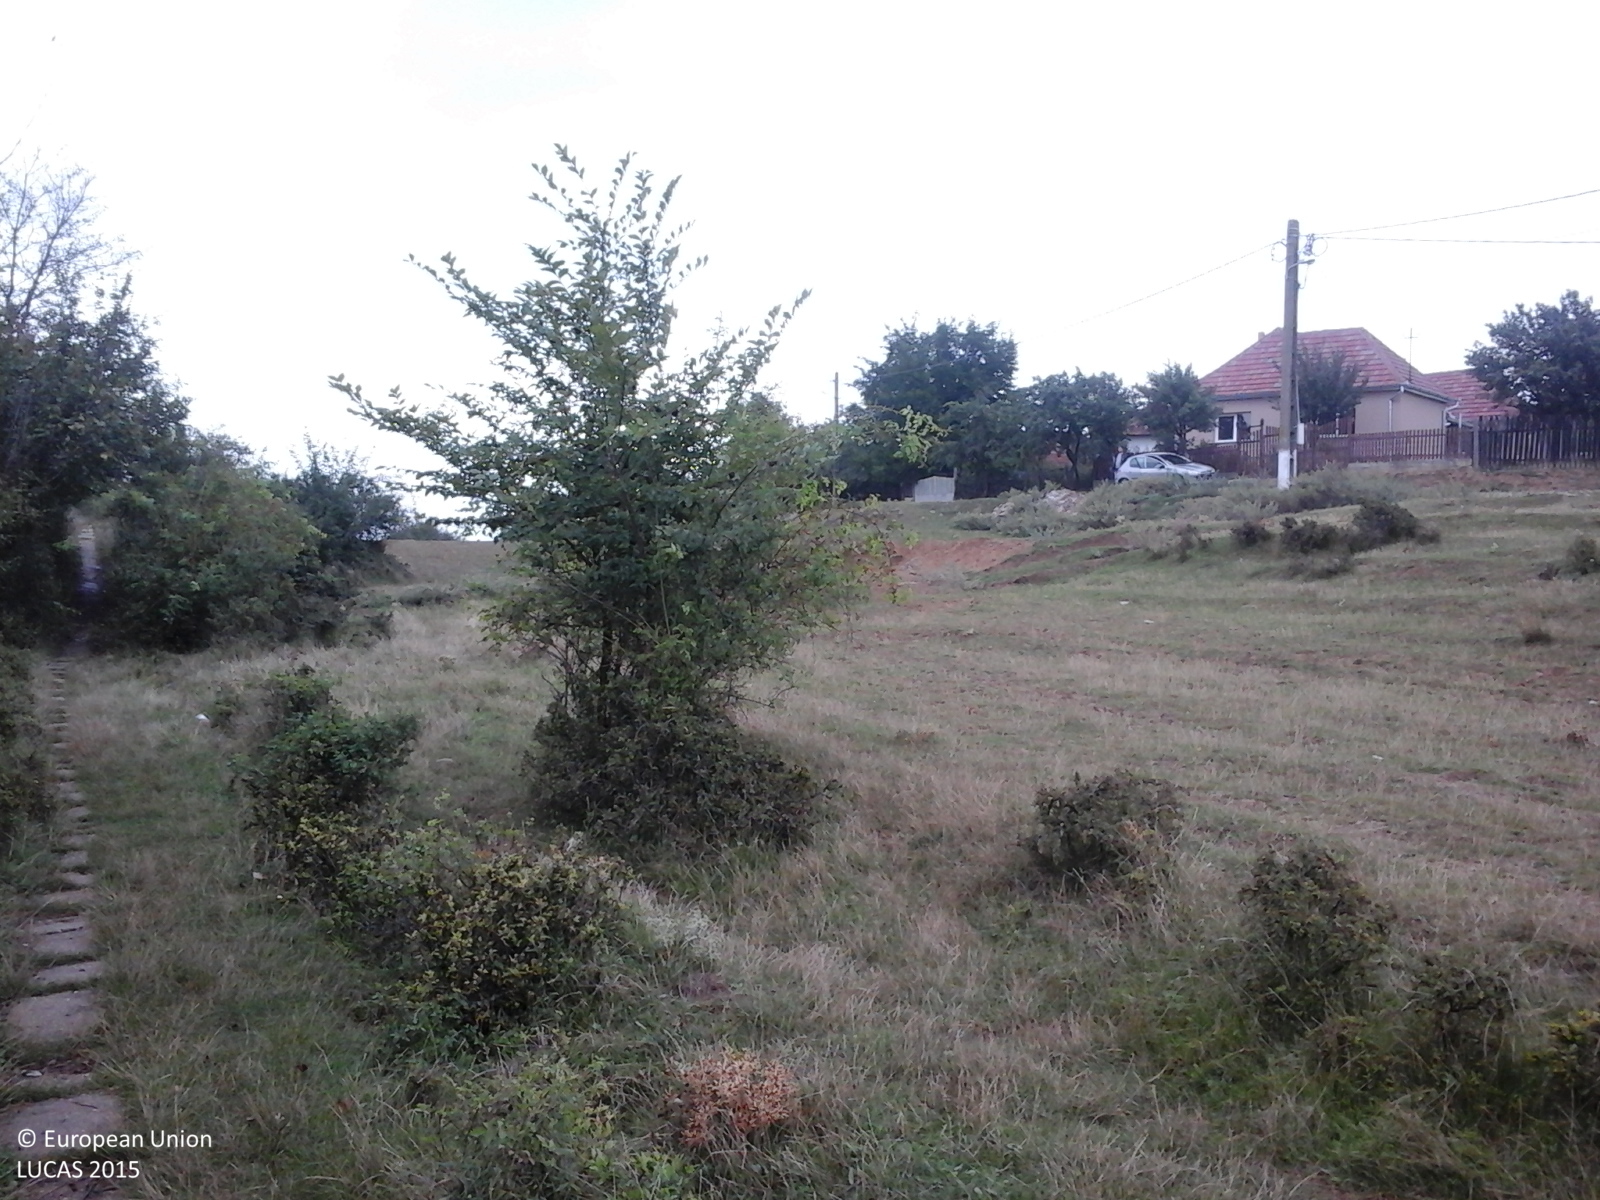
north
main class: Grassland
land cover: Grassland without tree/shrub cover
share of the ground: > 75 %
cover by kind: herbaceous plants 100 %
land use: Agriculture (excluding fallow land and kitchen gardens)
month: September
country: RO
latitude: 47.2671
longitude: 22.3855
